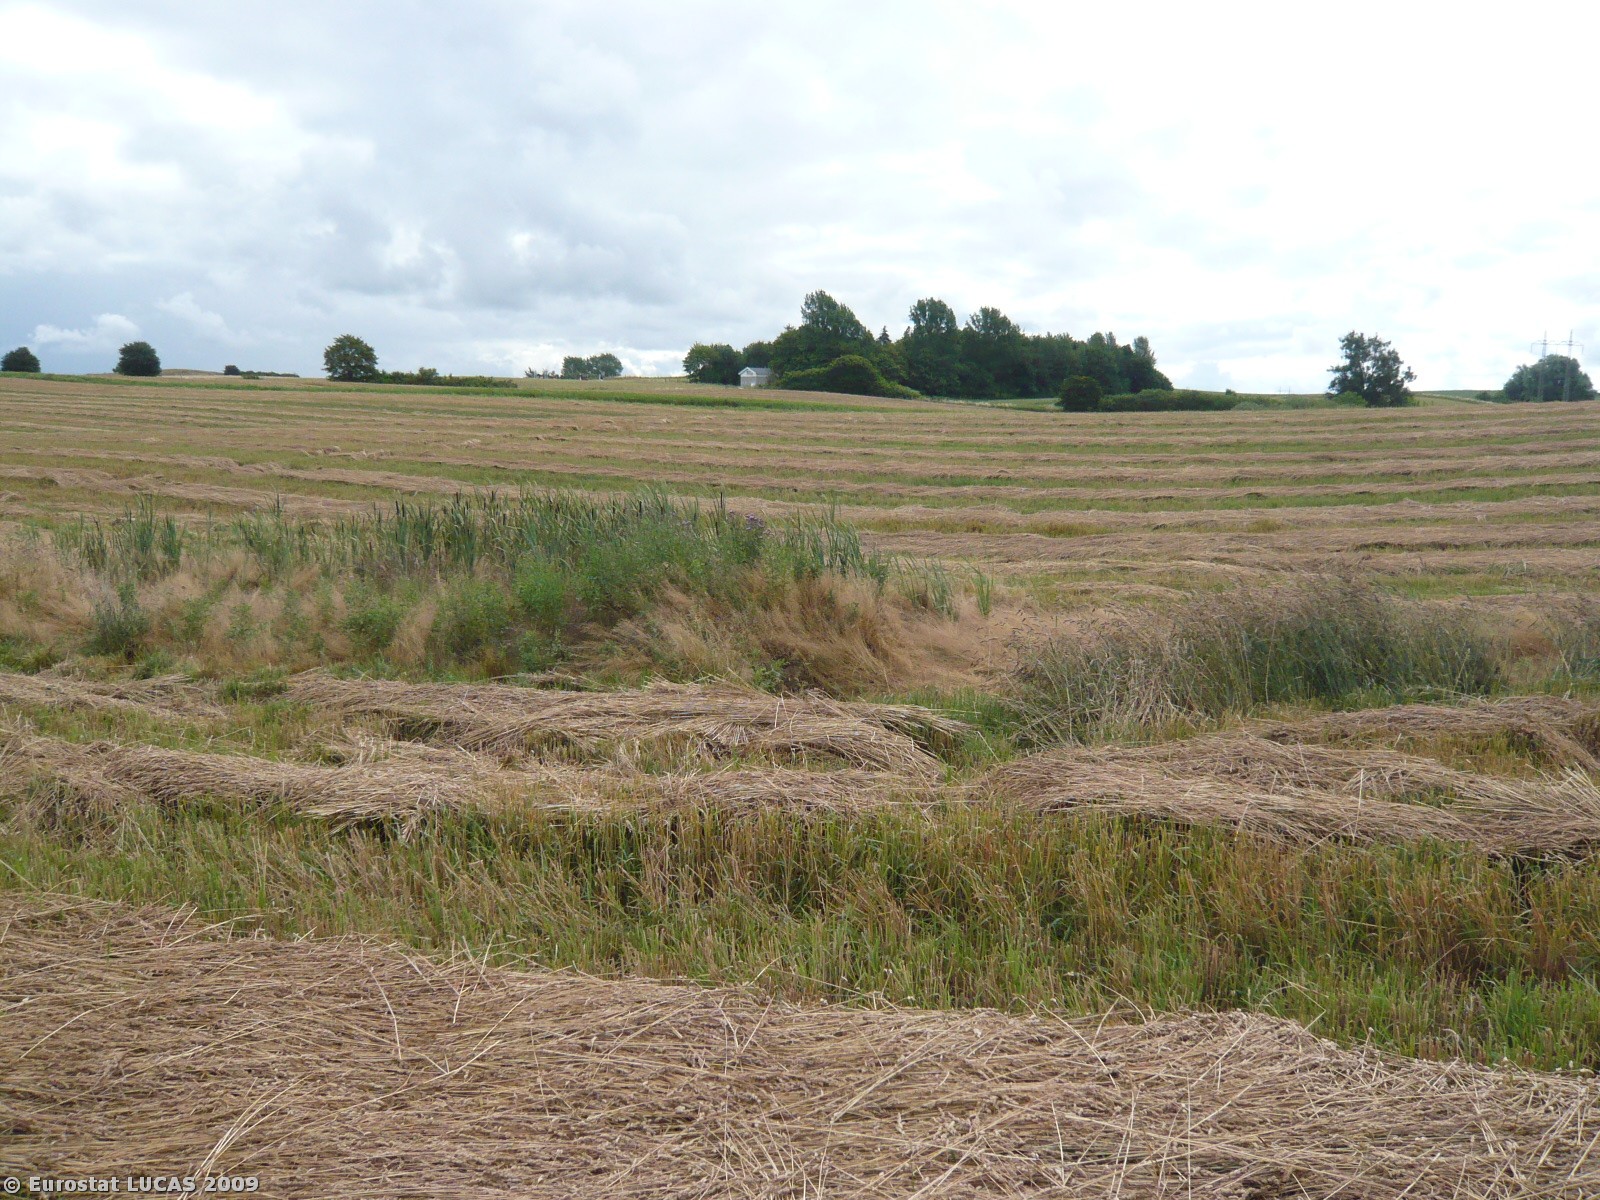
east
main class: Grassland
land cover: Grassland without tree/shrub cover
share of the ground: > 75 %
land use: Agriculture (excluding fallow land and kitchen gardens)
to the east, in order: Grassland without tree/shrub cover; Inland marshes; Grassland without tree/shrub cover; Grass margins; Tracks; Grass margins; Grassland without tree/shrub cover
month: July
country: DK
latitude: 55.6240
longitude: 11.2851
